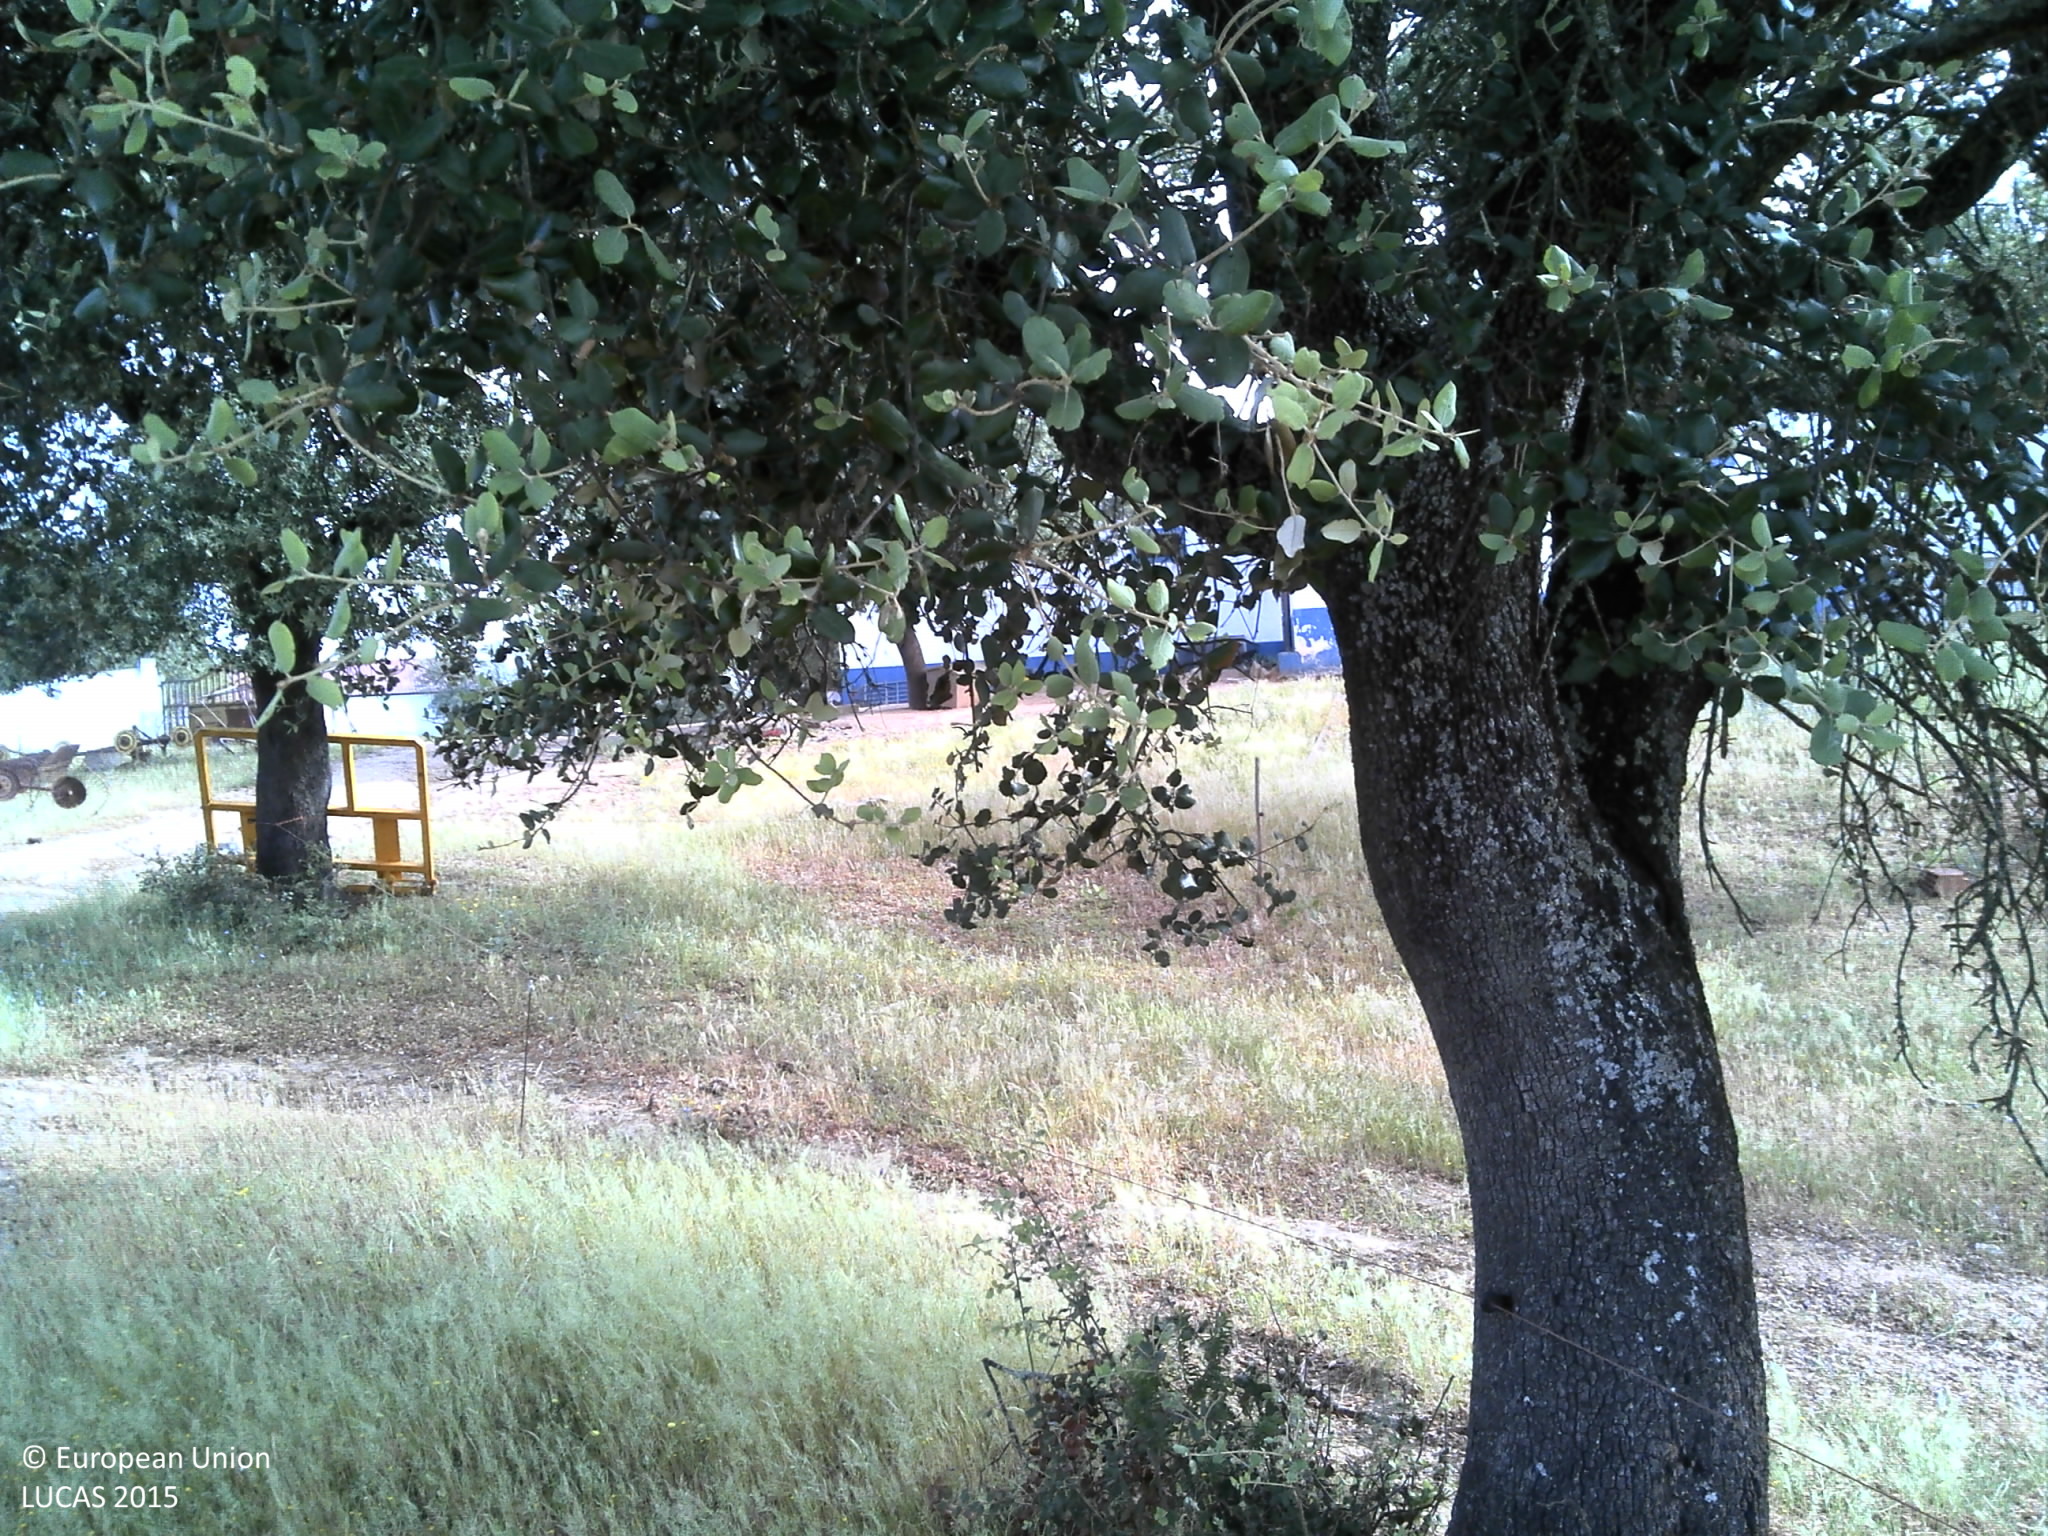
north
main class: Woodland
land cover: Broadleaved woodland
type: broadleaved evergreen forest
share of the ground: 25 - 50 %
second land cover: Grassland without tree/shrub cover
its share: 25 - 50 %
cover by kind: unconsolidated bare surface 40 %, broadleaved forest trees 30 %, herbaceous plants 30 %
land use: Agriculture (excluding fallow land and kitchen gardens)
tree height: > 5 m
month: May
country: PT
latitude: 38.4423
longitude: -8.4627
